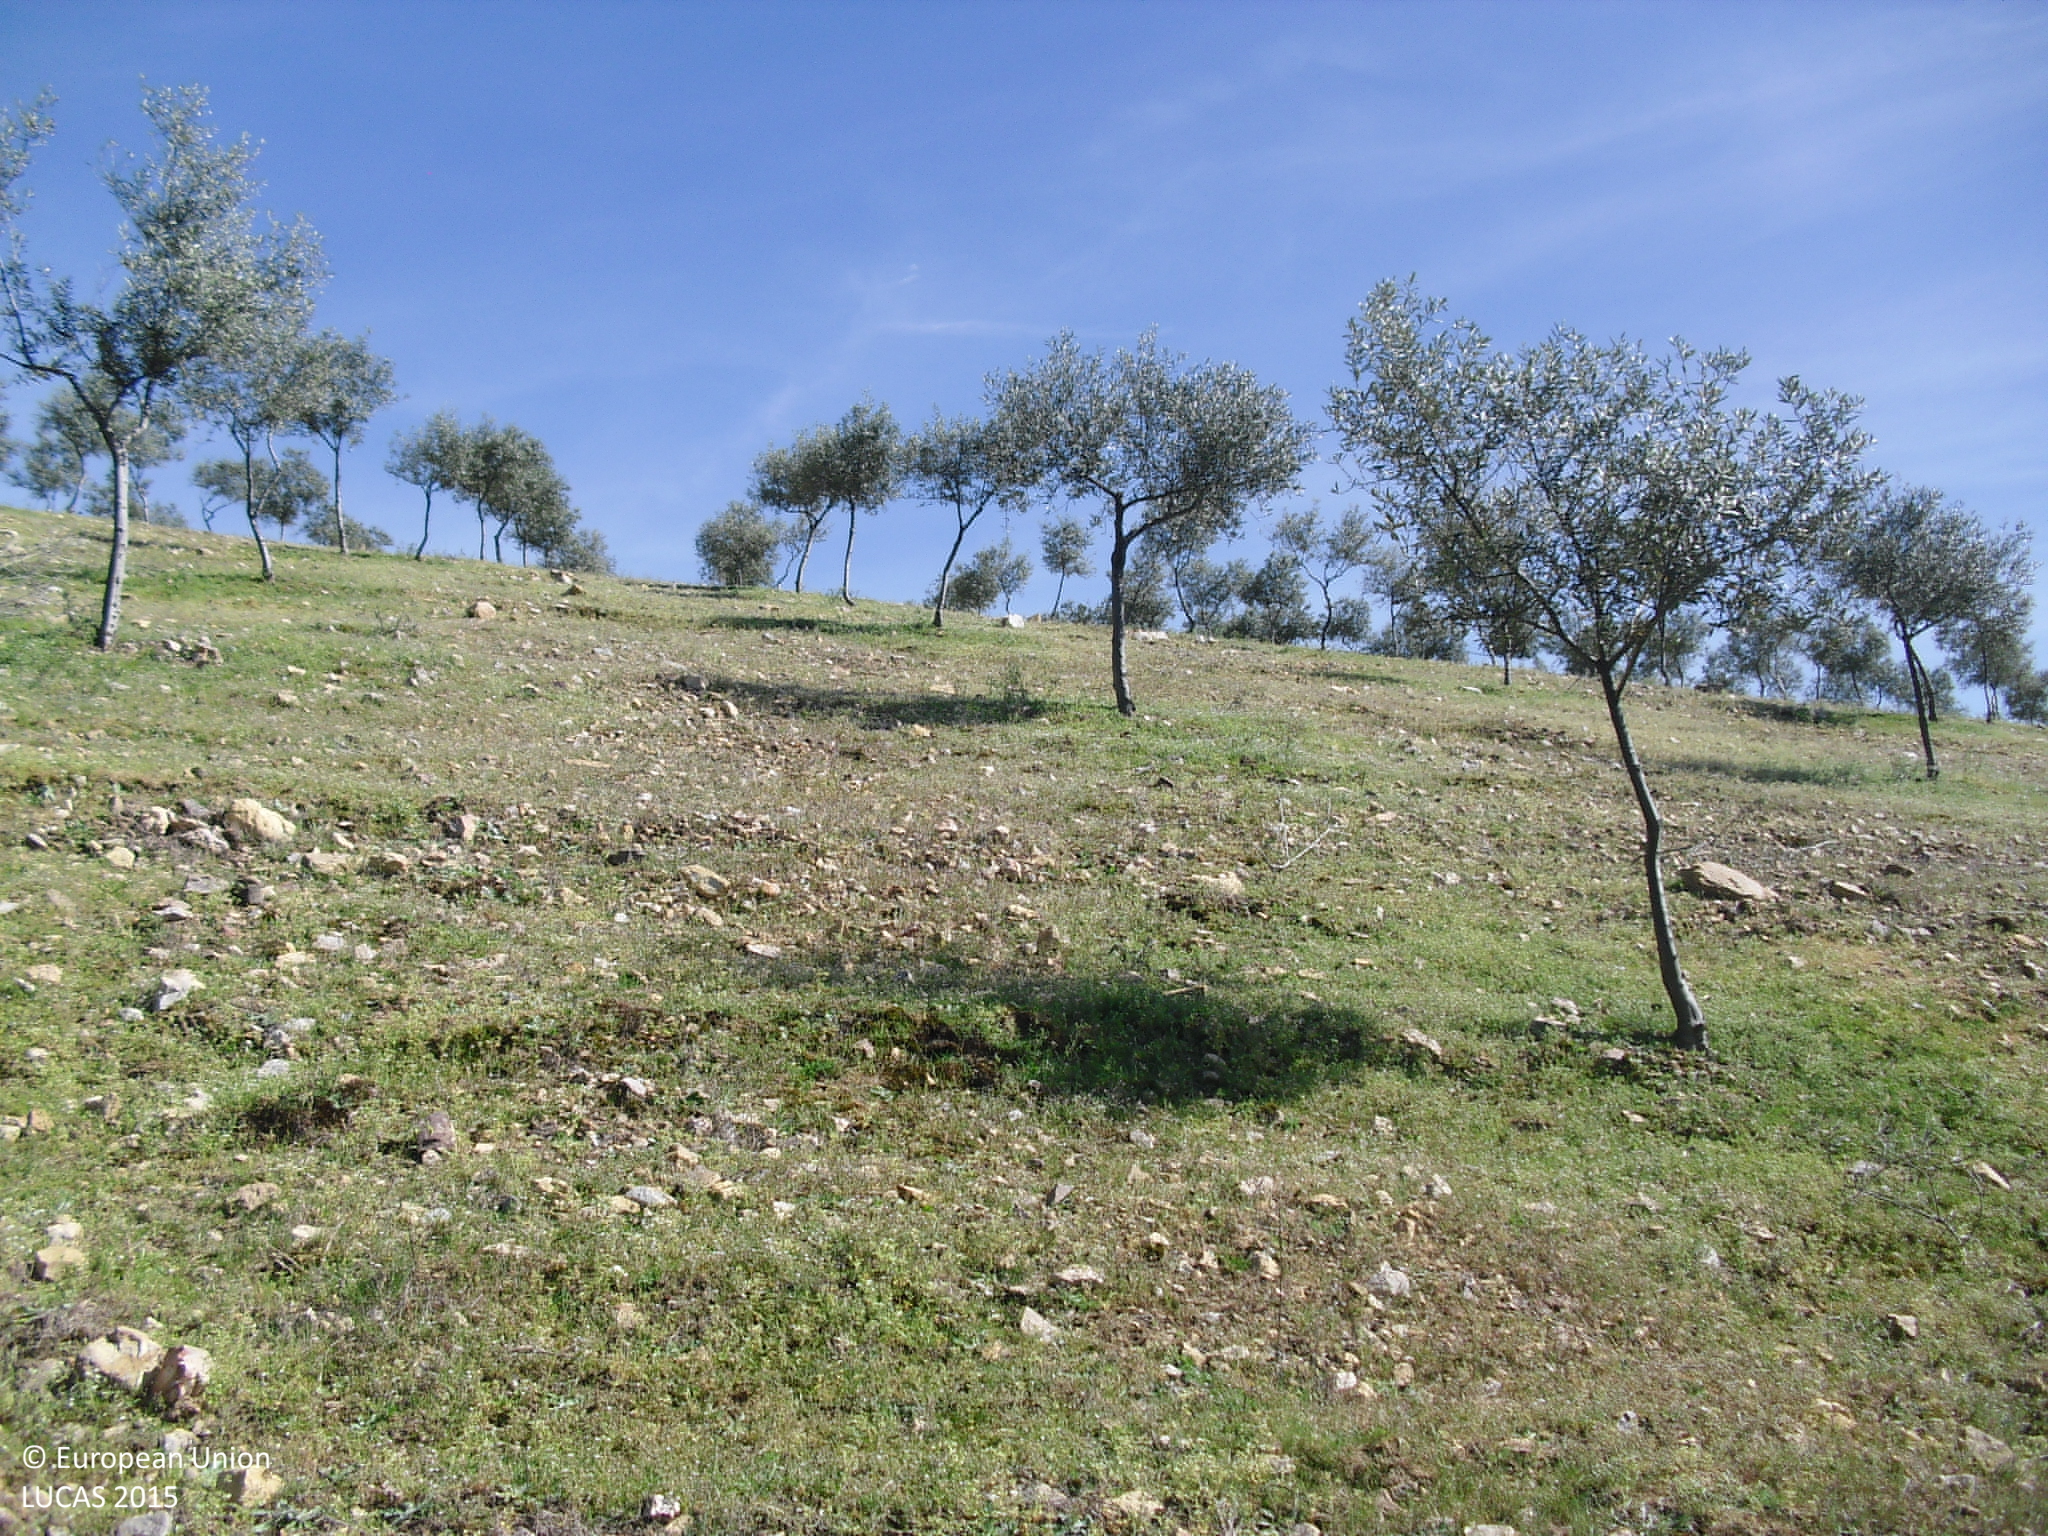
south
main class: Cropland
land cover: Olive groves
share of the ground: 10 - 25 %
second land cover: Spontaneously vegetated surfaces
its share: > 75 %
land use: Agriculture (excluding fallow land and kitchen gardens)
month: April
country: ES
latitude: 39.3665
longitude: -5.3330
